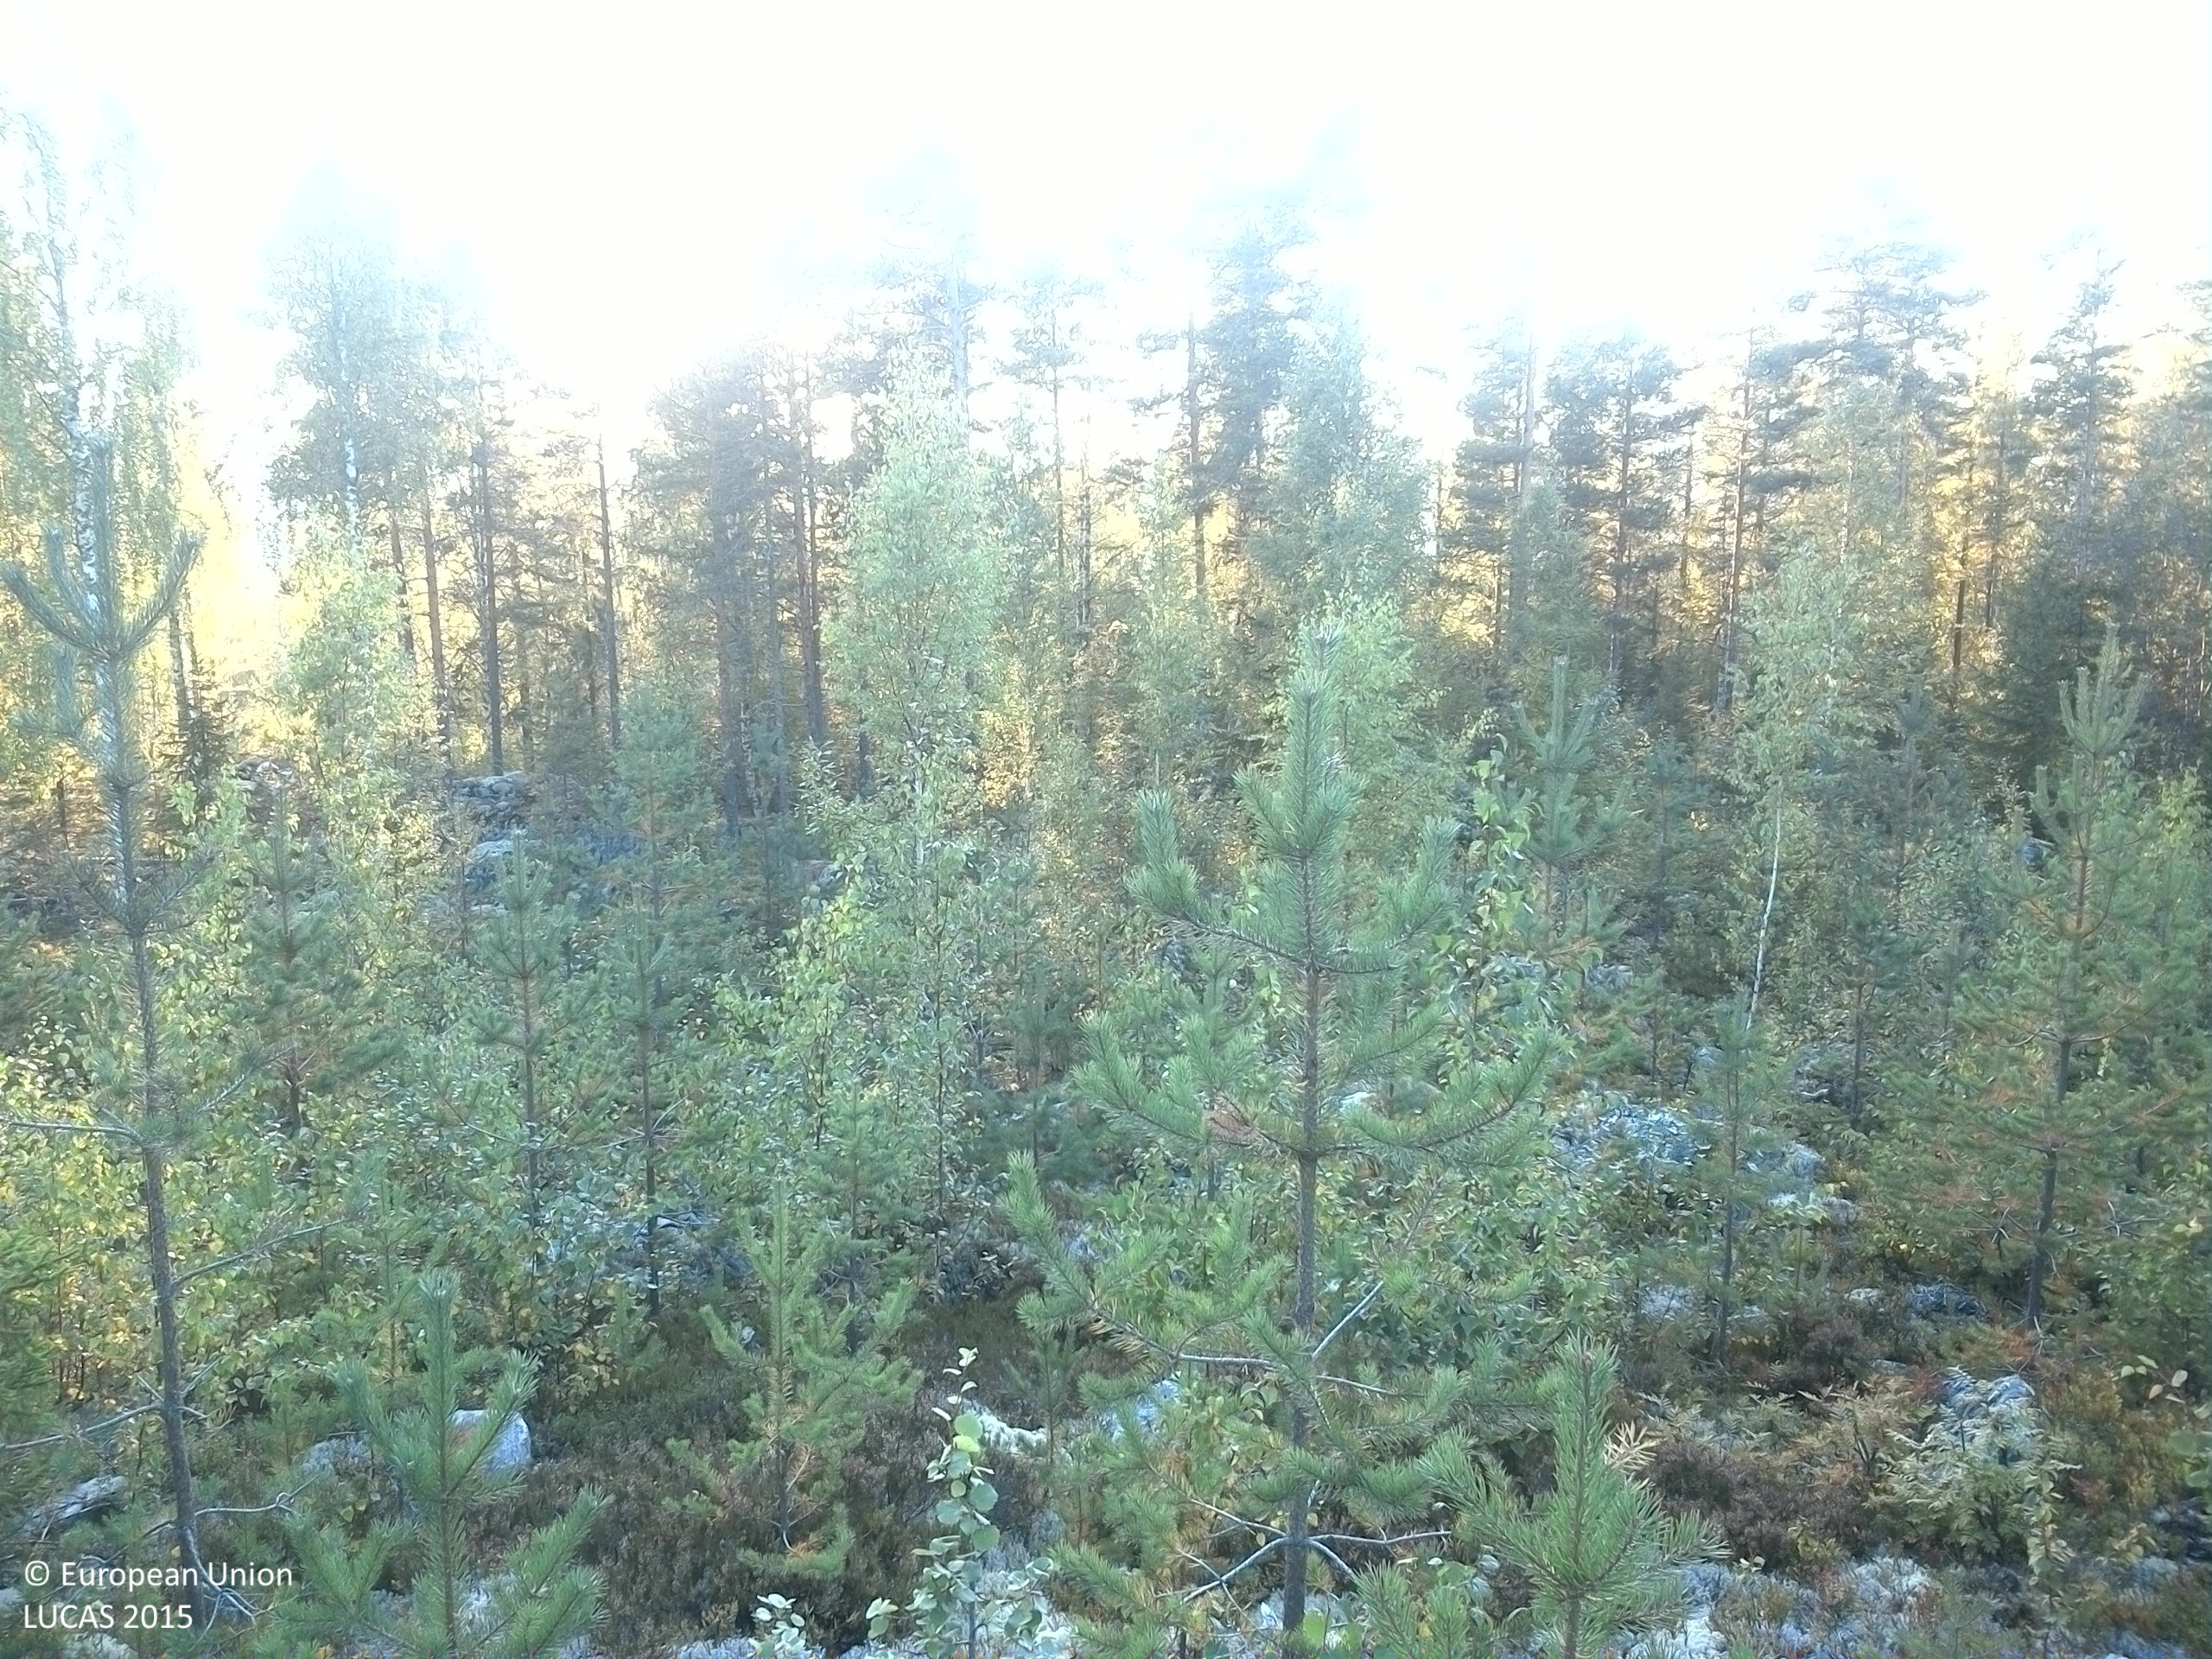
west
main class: Woodland
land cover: Pine dominated mixed woodland
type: boreal forest
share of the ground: 25 - 50 %
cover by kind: coniferous forest trees 30 %, shrubs 30 %, broadleaved forest trees 15 %, consolidated bare surface 15 %, lichens and mosses 10 %
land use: Forestry
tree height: < 5 m
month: September
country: SE
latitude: 61.6481
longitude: 15.4010
